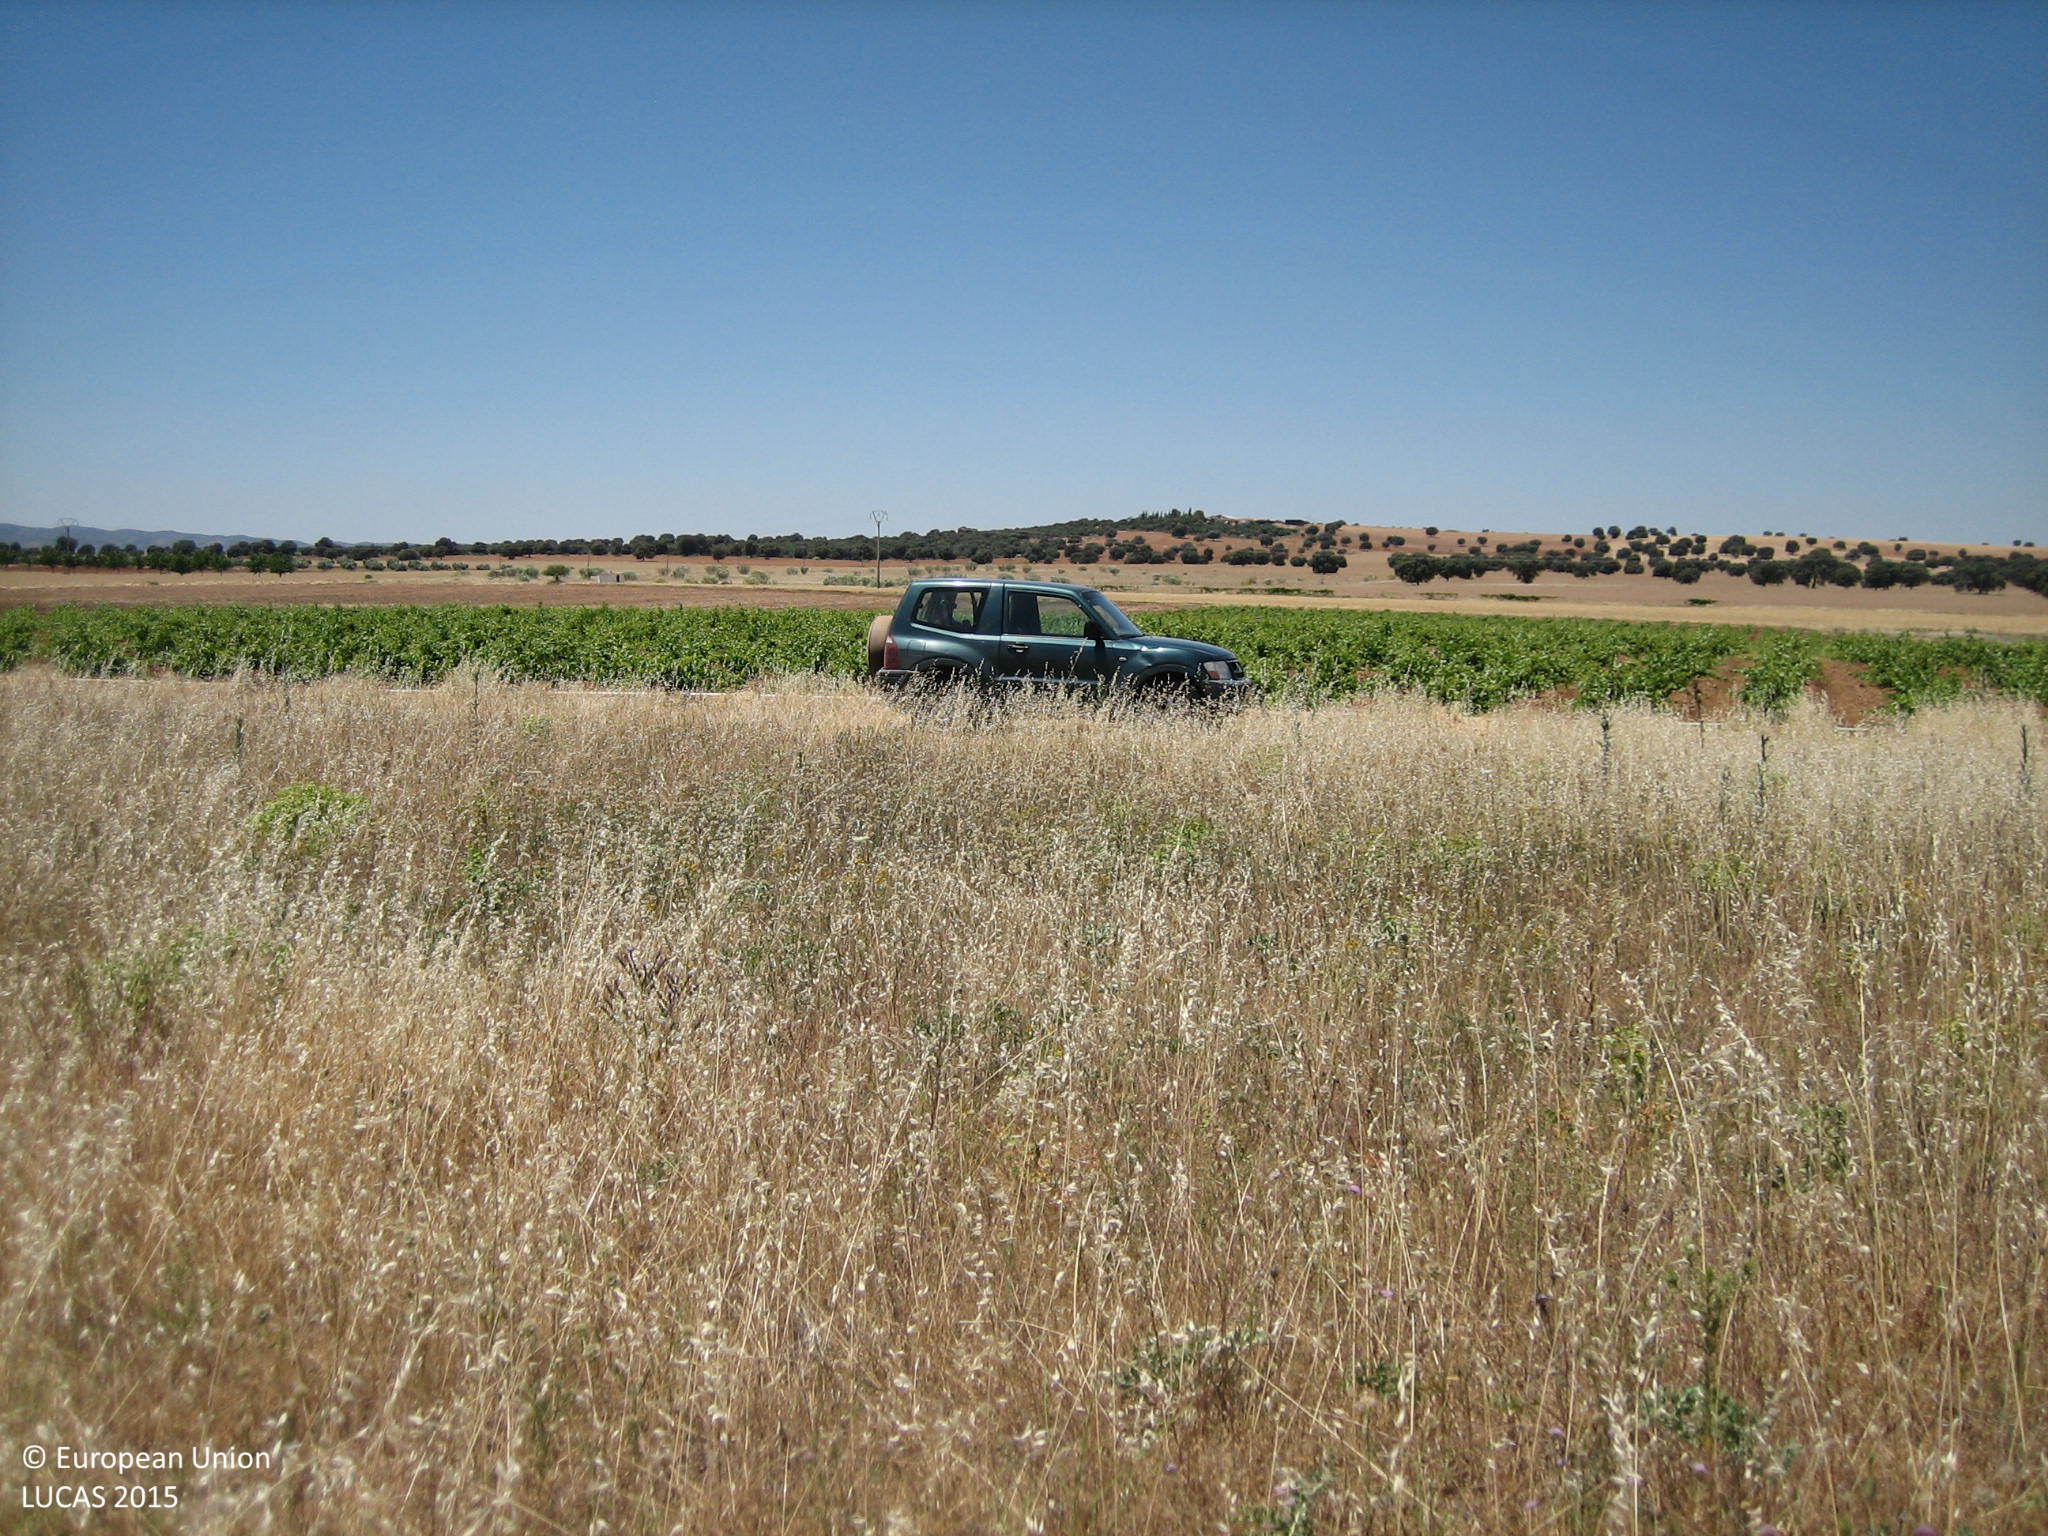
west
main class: Grassland
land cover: Spontaneously vegetated surfaces
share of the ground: > 75 %
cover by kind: herbaceous plants 100 %
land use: Fallow land
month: June
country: ES
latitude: 38.7772
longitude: -4.0271
